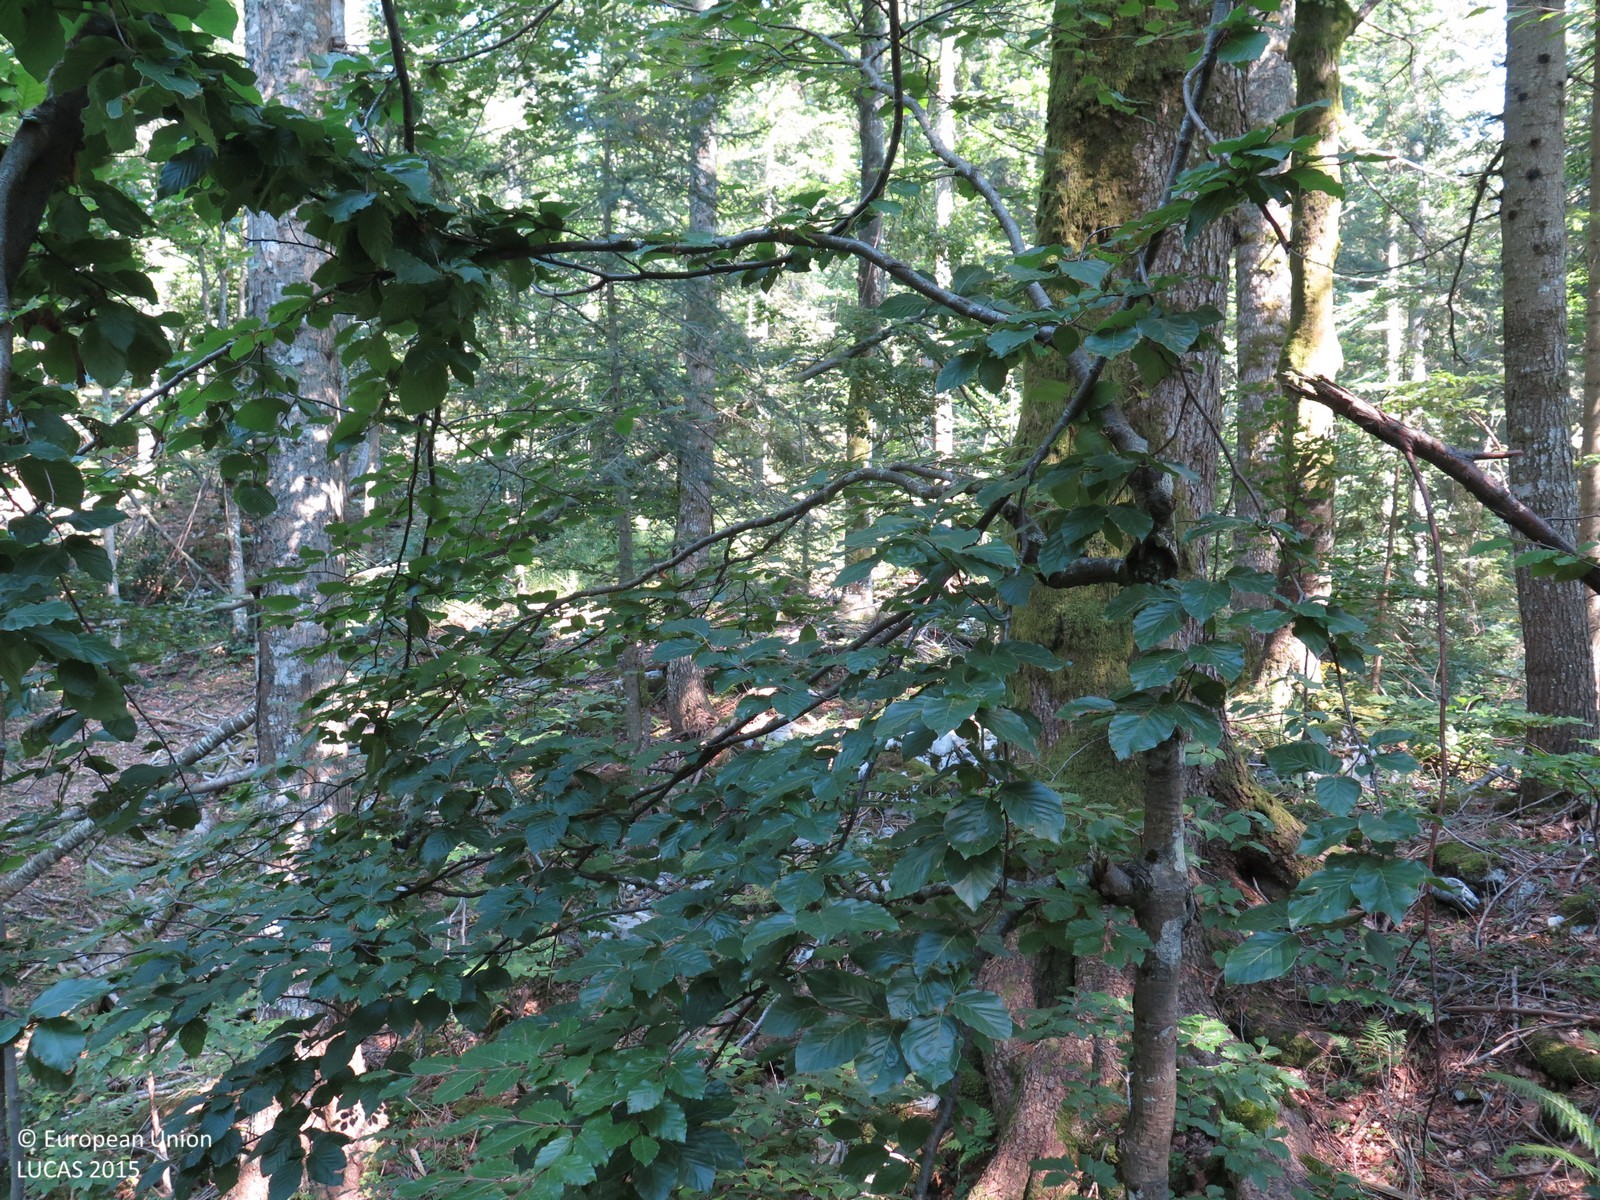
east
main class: Woodland
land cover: Other mixed woodland
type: mountainous beech forest
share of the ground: > 75 %
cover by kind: coniferous forest trees 75 %, broadleaved forest trees 25 %
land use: Forestry
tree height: > 5 m
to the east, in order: Other mixed woodland
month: August
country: HR
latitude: 45.5309
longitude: 14.5923
